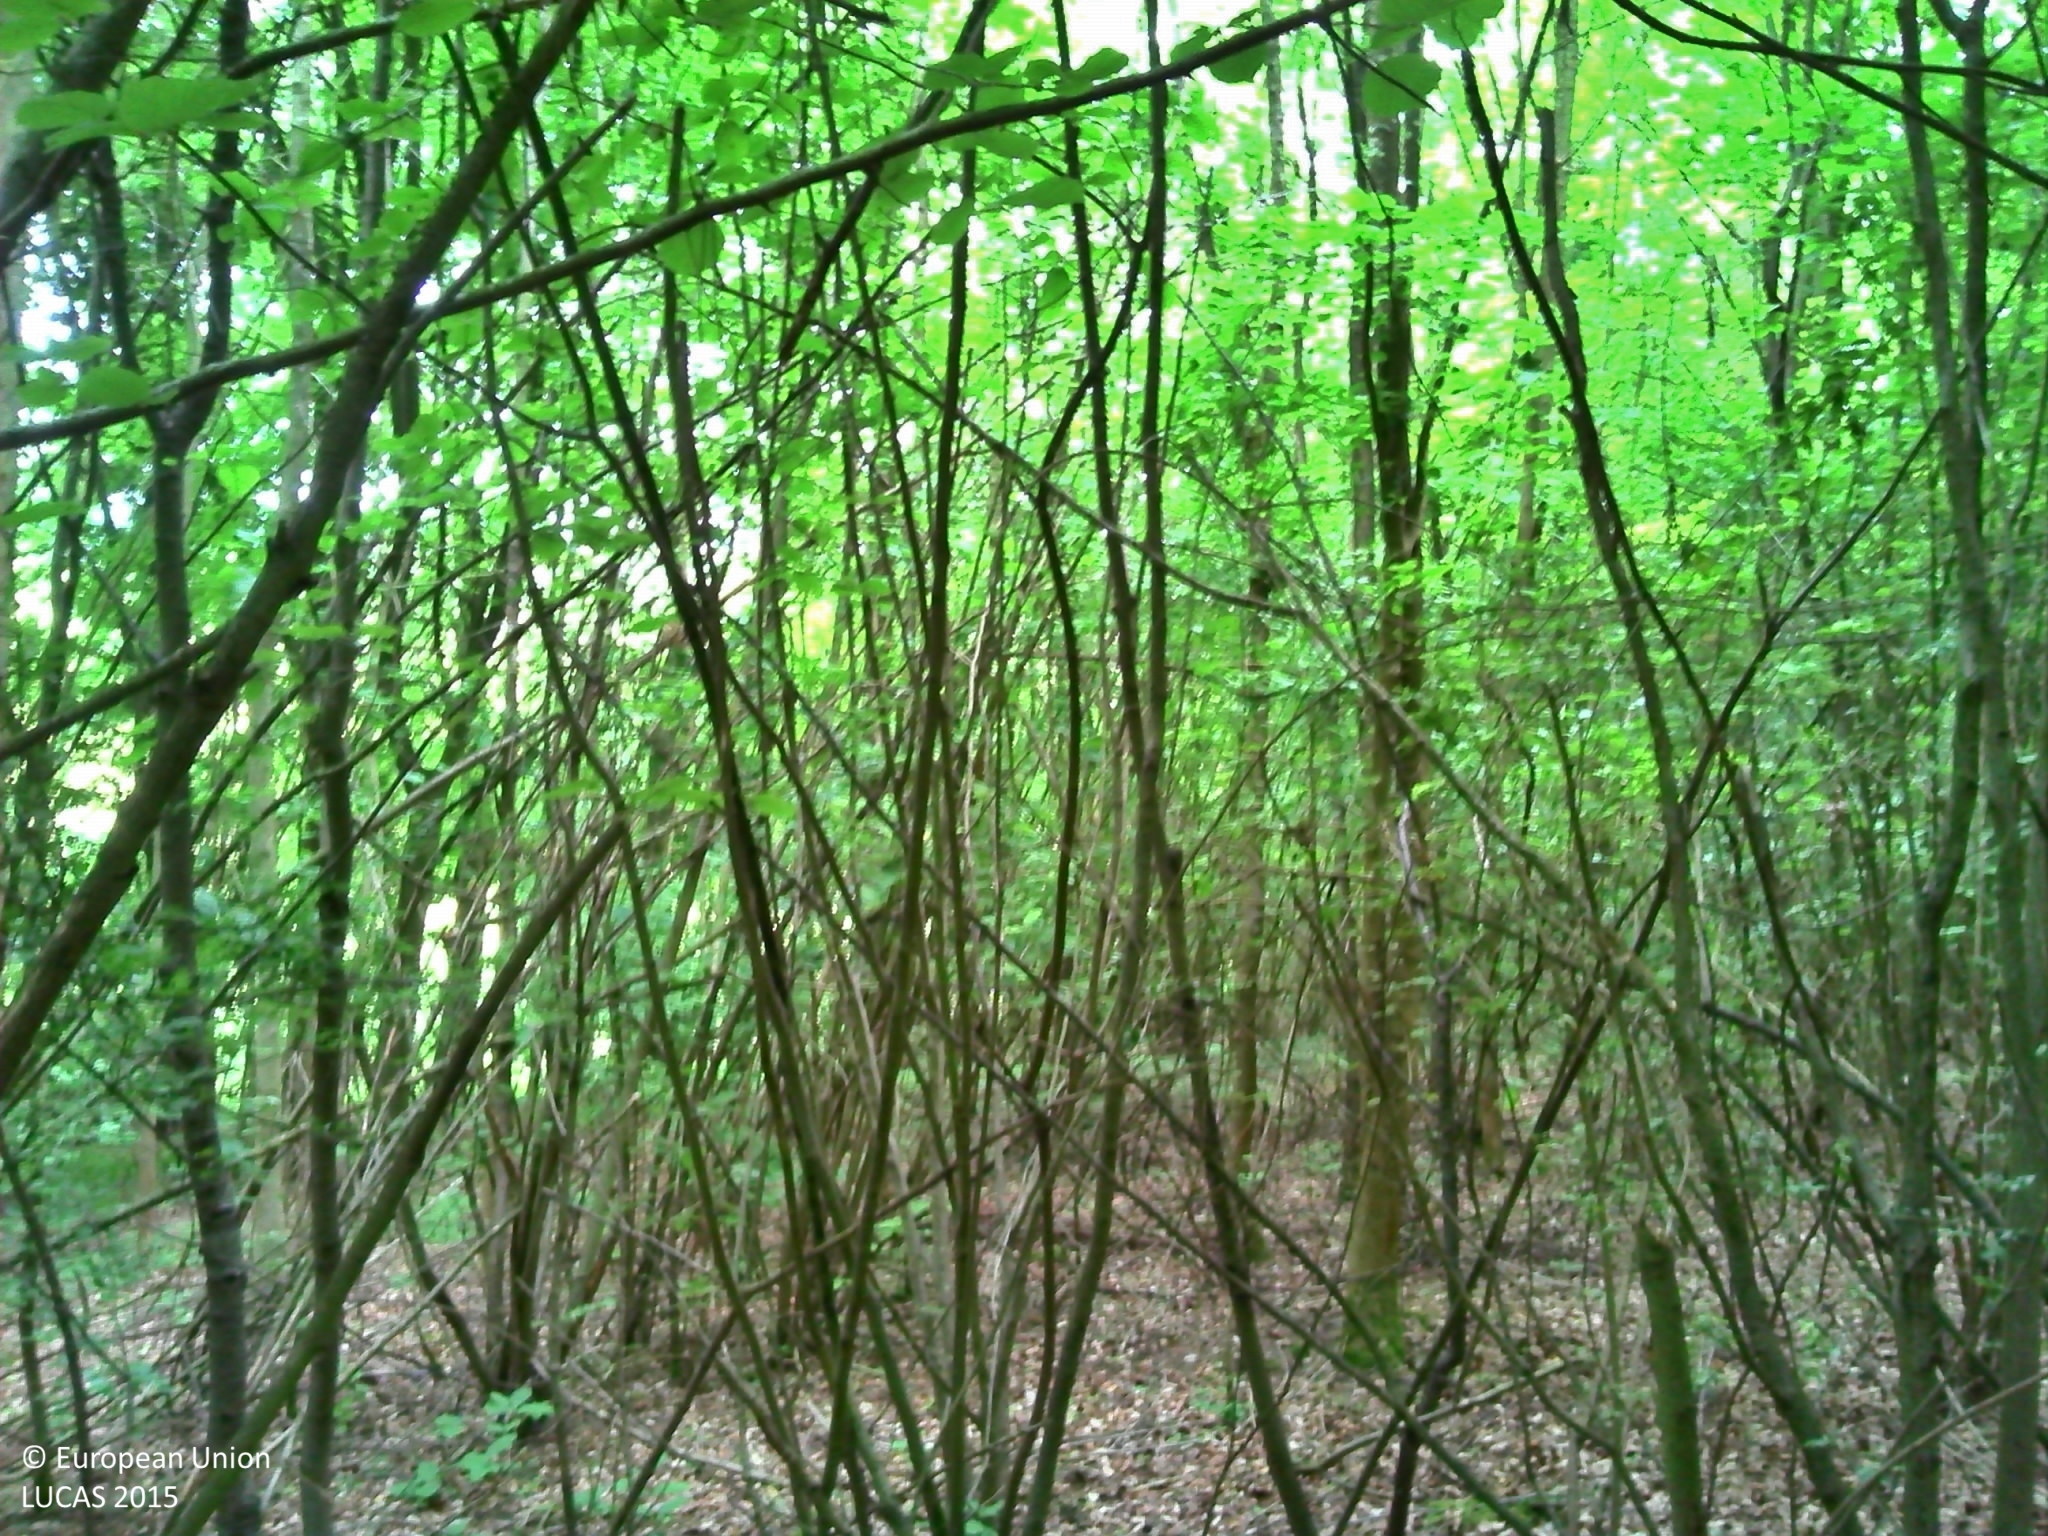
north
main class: Woodland
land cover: Broadleaved woodland
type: beech forest
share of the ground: > 75 %
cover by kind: broadleaved forest trees 85 %, herbaceous plants 10 %, shrubs 5 %
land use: Forestry
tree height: > 5 m
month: June
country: FR
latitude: 49.5754
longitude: 2.2281
